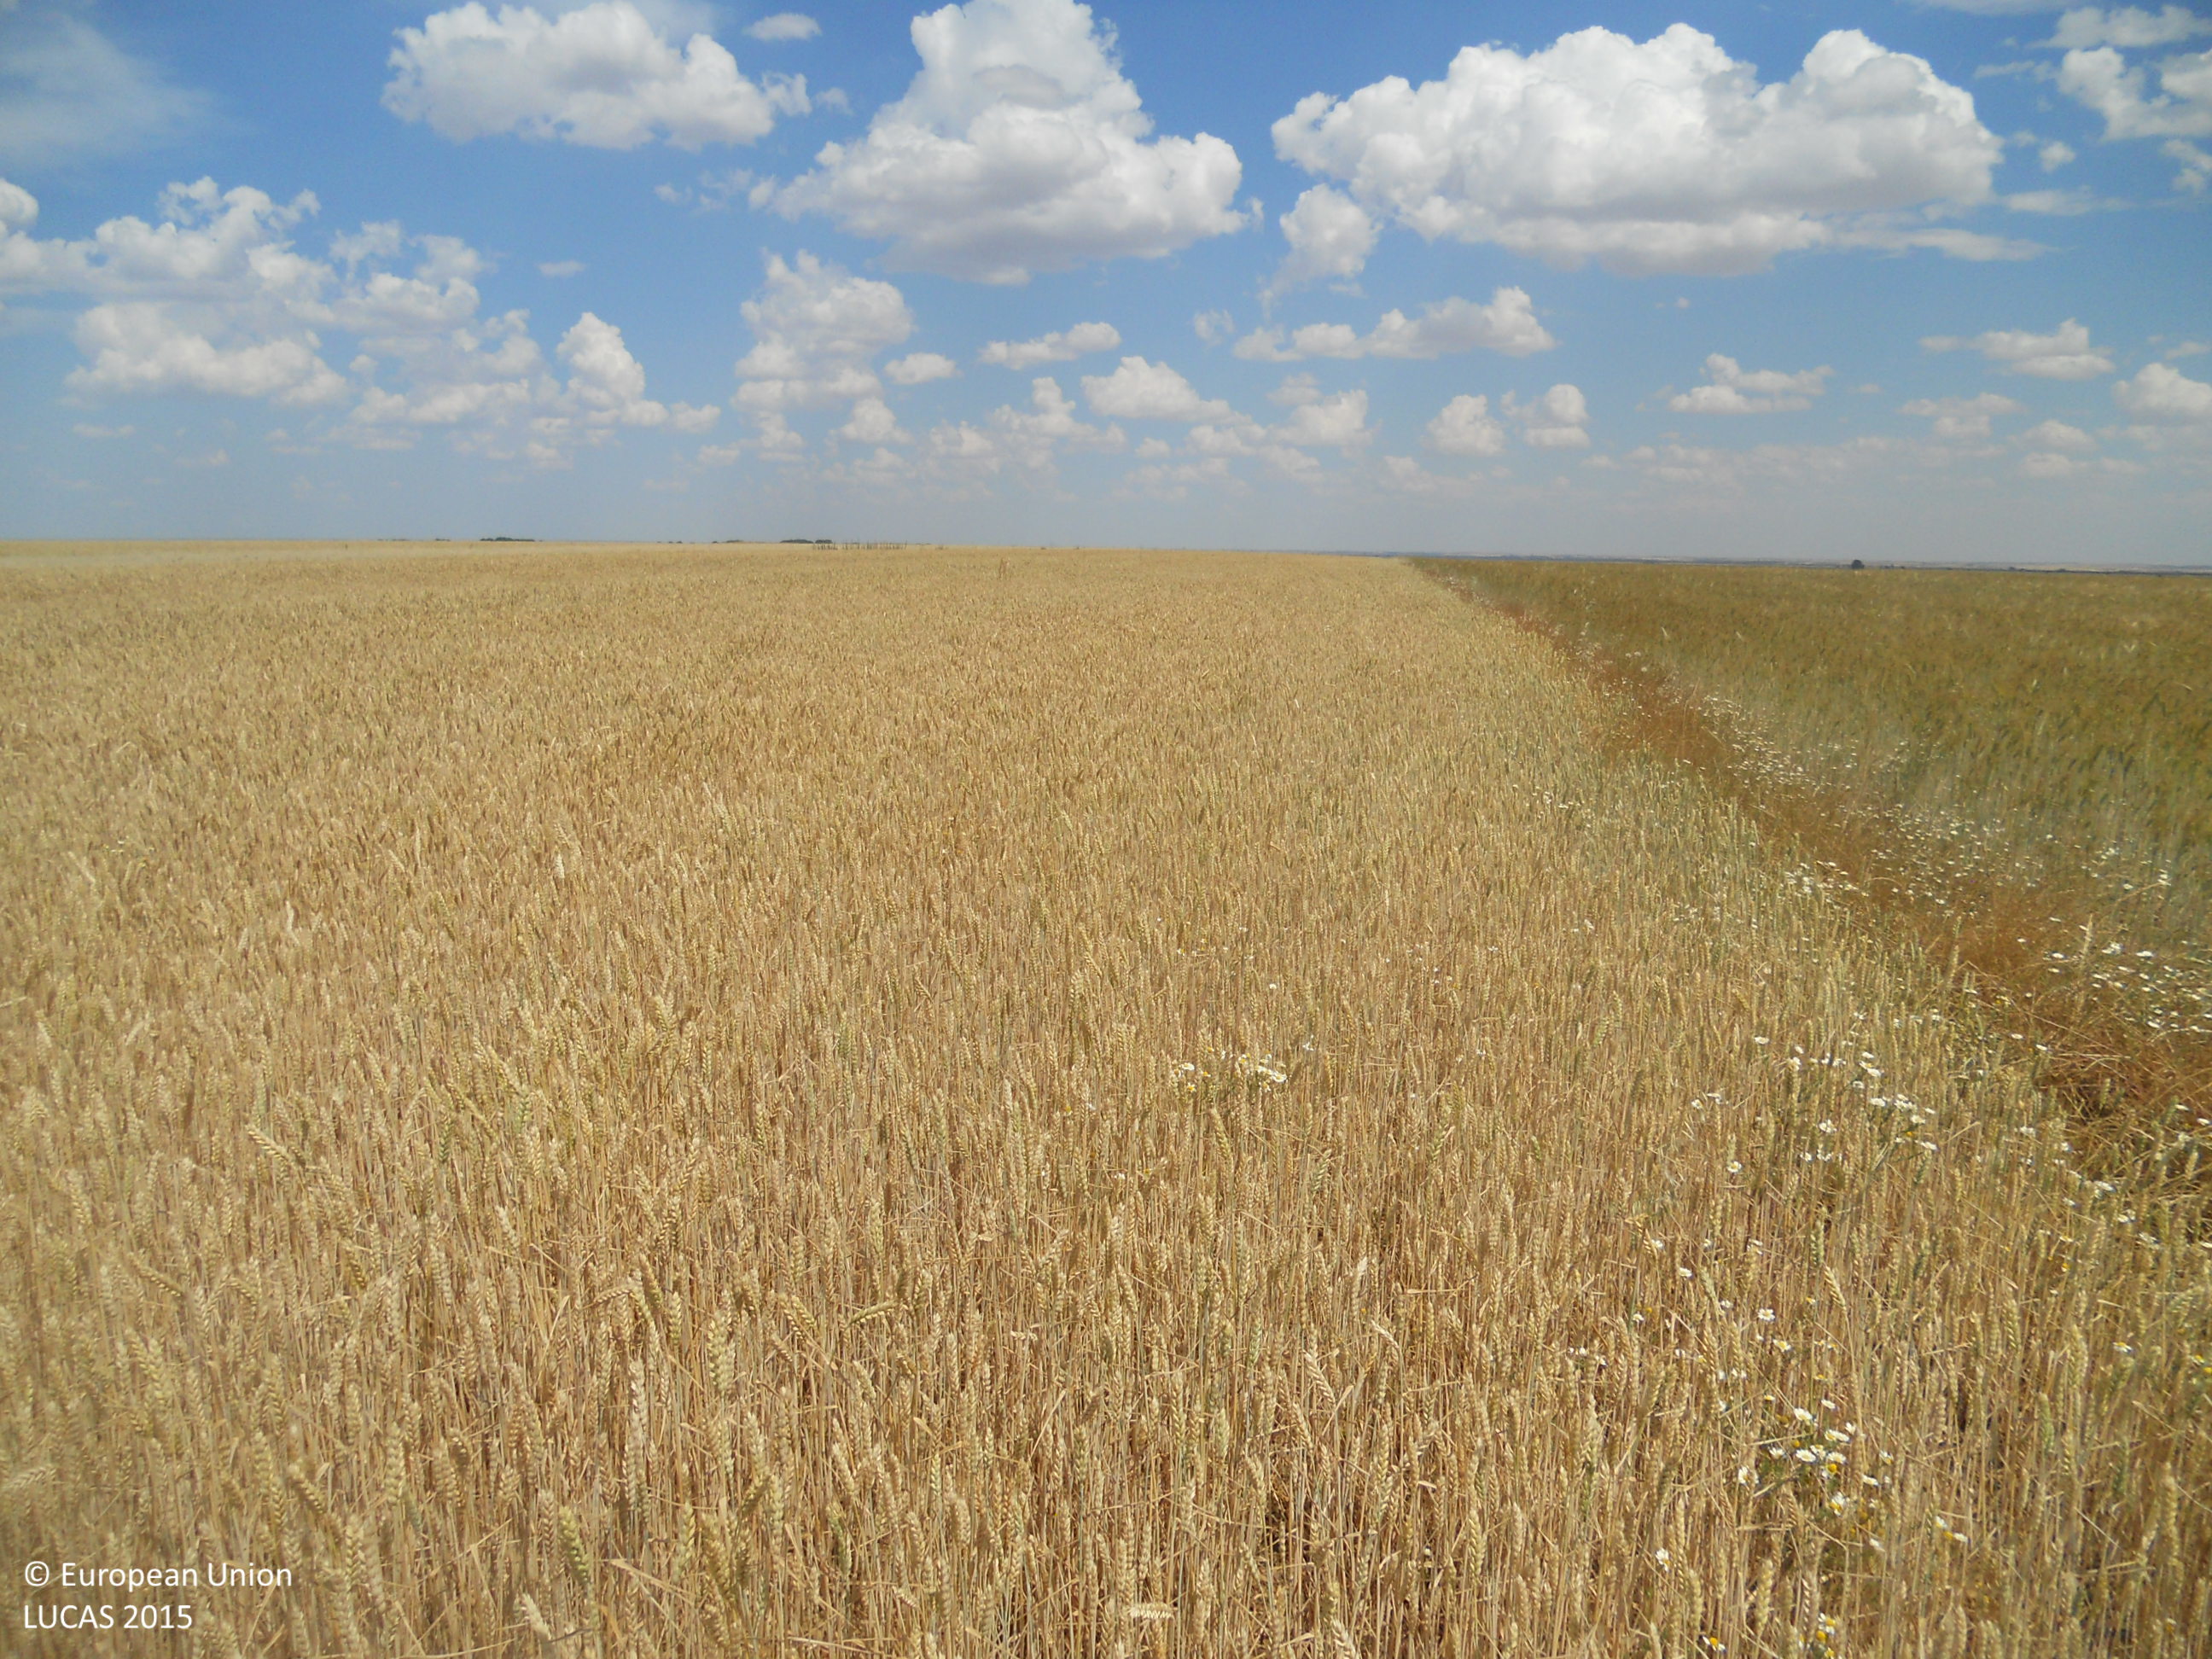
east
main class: Cropland
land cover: Common wheat
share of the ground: > 75 %
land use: Agriculture (excluding fallow land and kitchen gardens)
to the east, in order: Common wheat; Grass margins; Oats
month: June
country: ES
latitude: 42.2823
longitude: -5.3562
